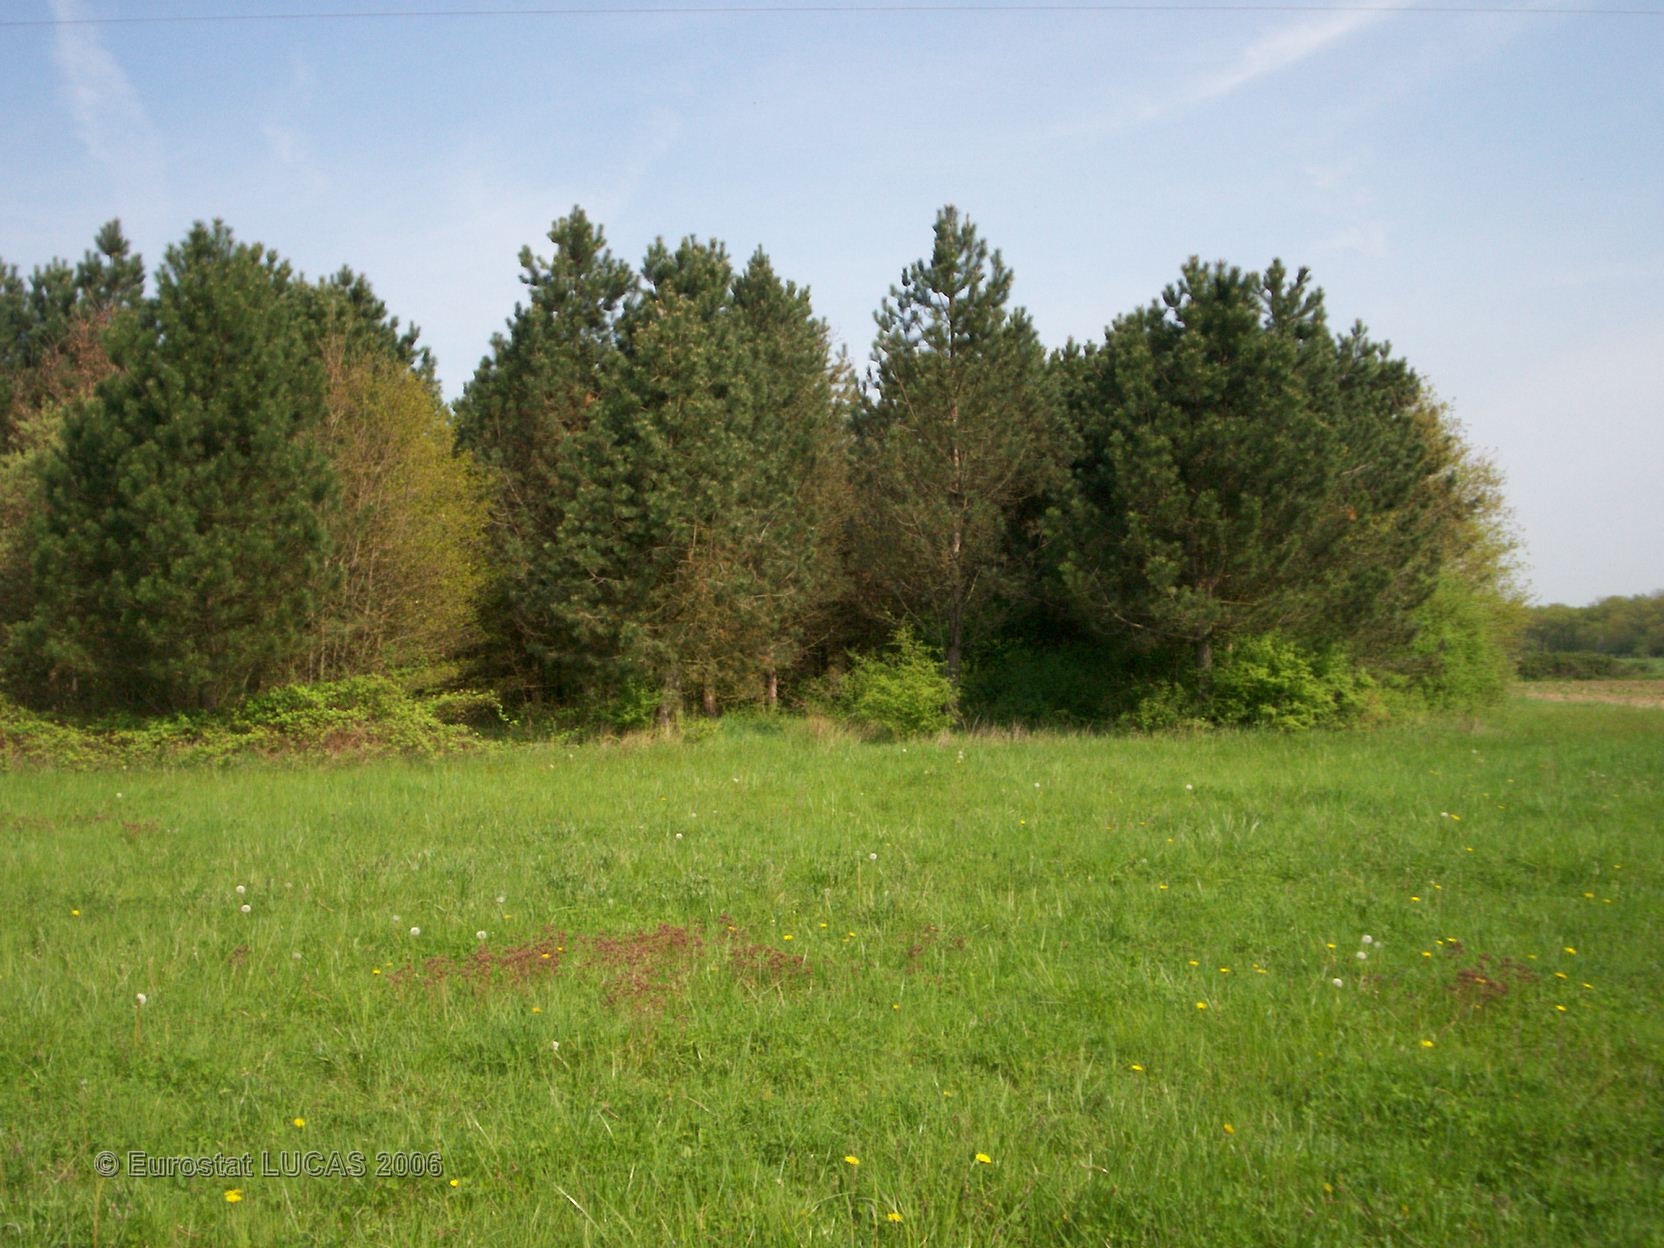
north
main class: Grassland
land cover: Grassland with sparse tree/shrub cover
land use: Agriculture (excluding fallow land and kitchen gardens)
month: May
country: FR
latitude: 48.0894
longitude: 2.9709
